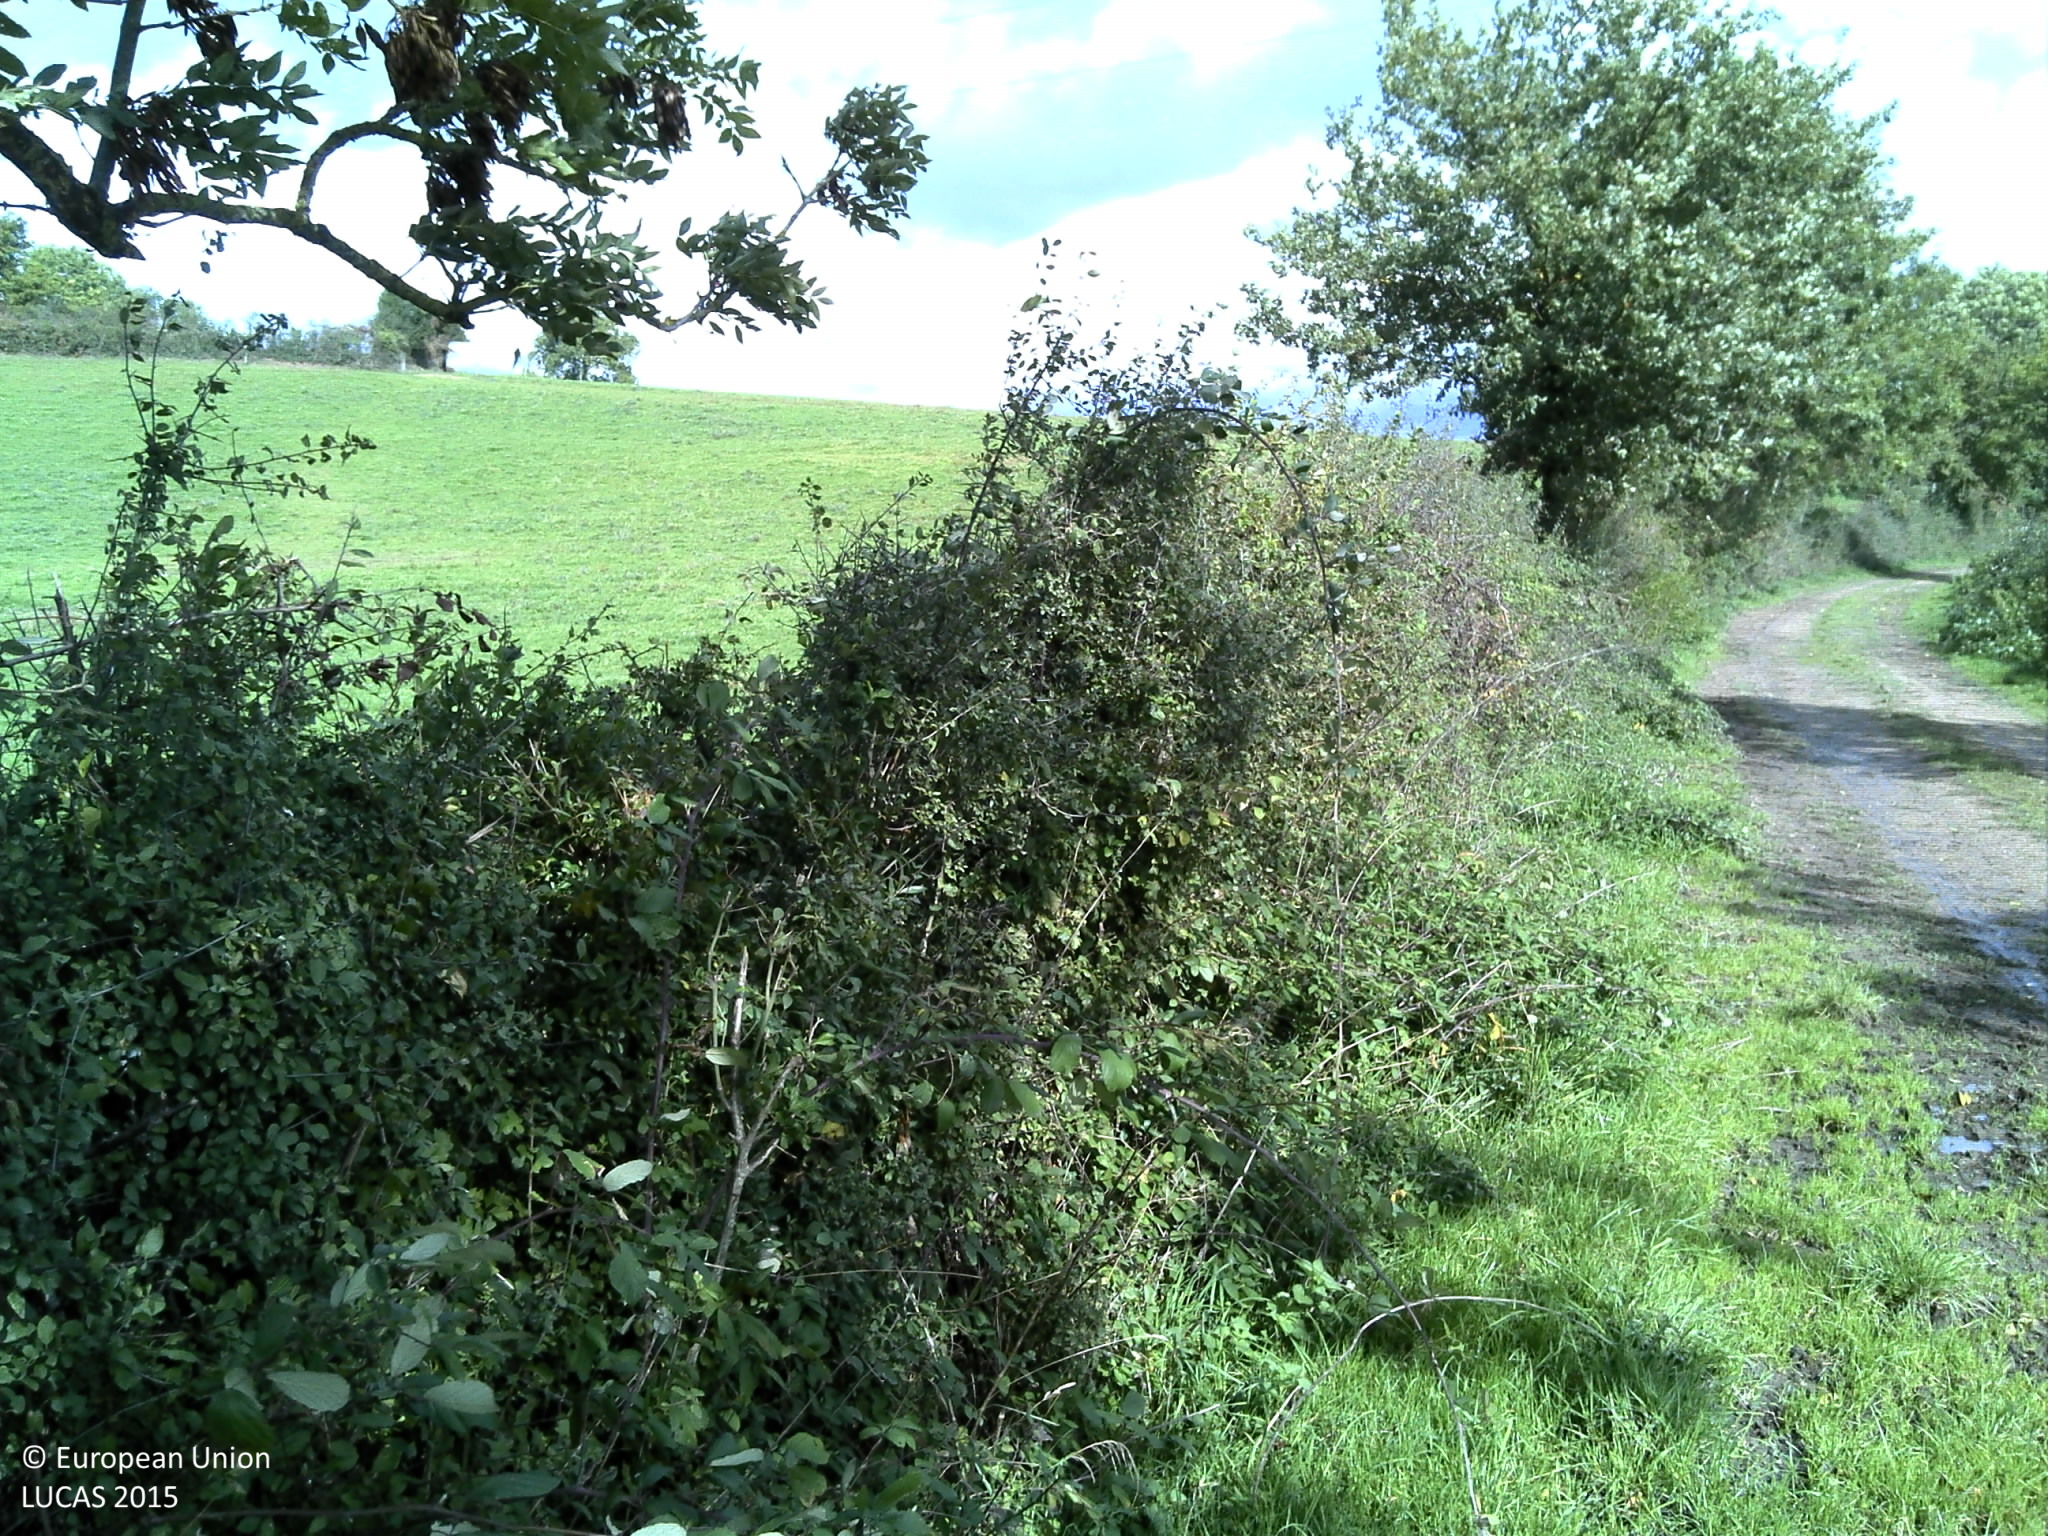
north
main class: Grassland
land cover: Grassland without tree/shrub cover
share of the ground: > 75 %
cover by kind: herbaceous plants 100 %
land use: Agriculture (excluding fallow land and kitchen gardens)
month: October
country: FR
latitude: 46.6194
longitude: 4.0583
